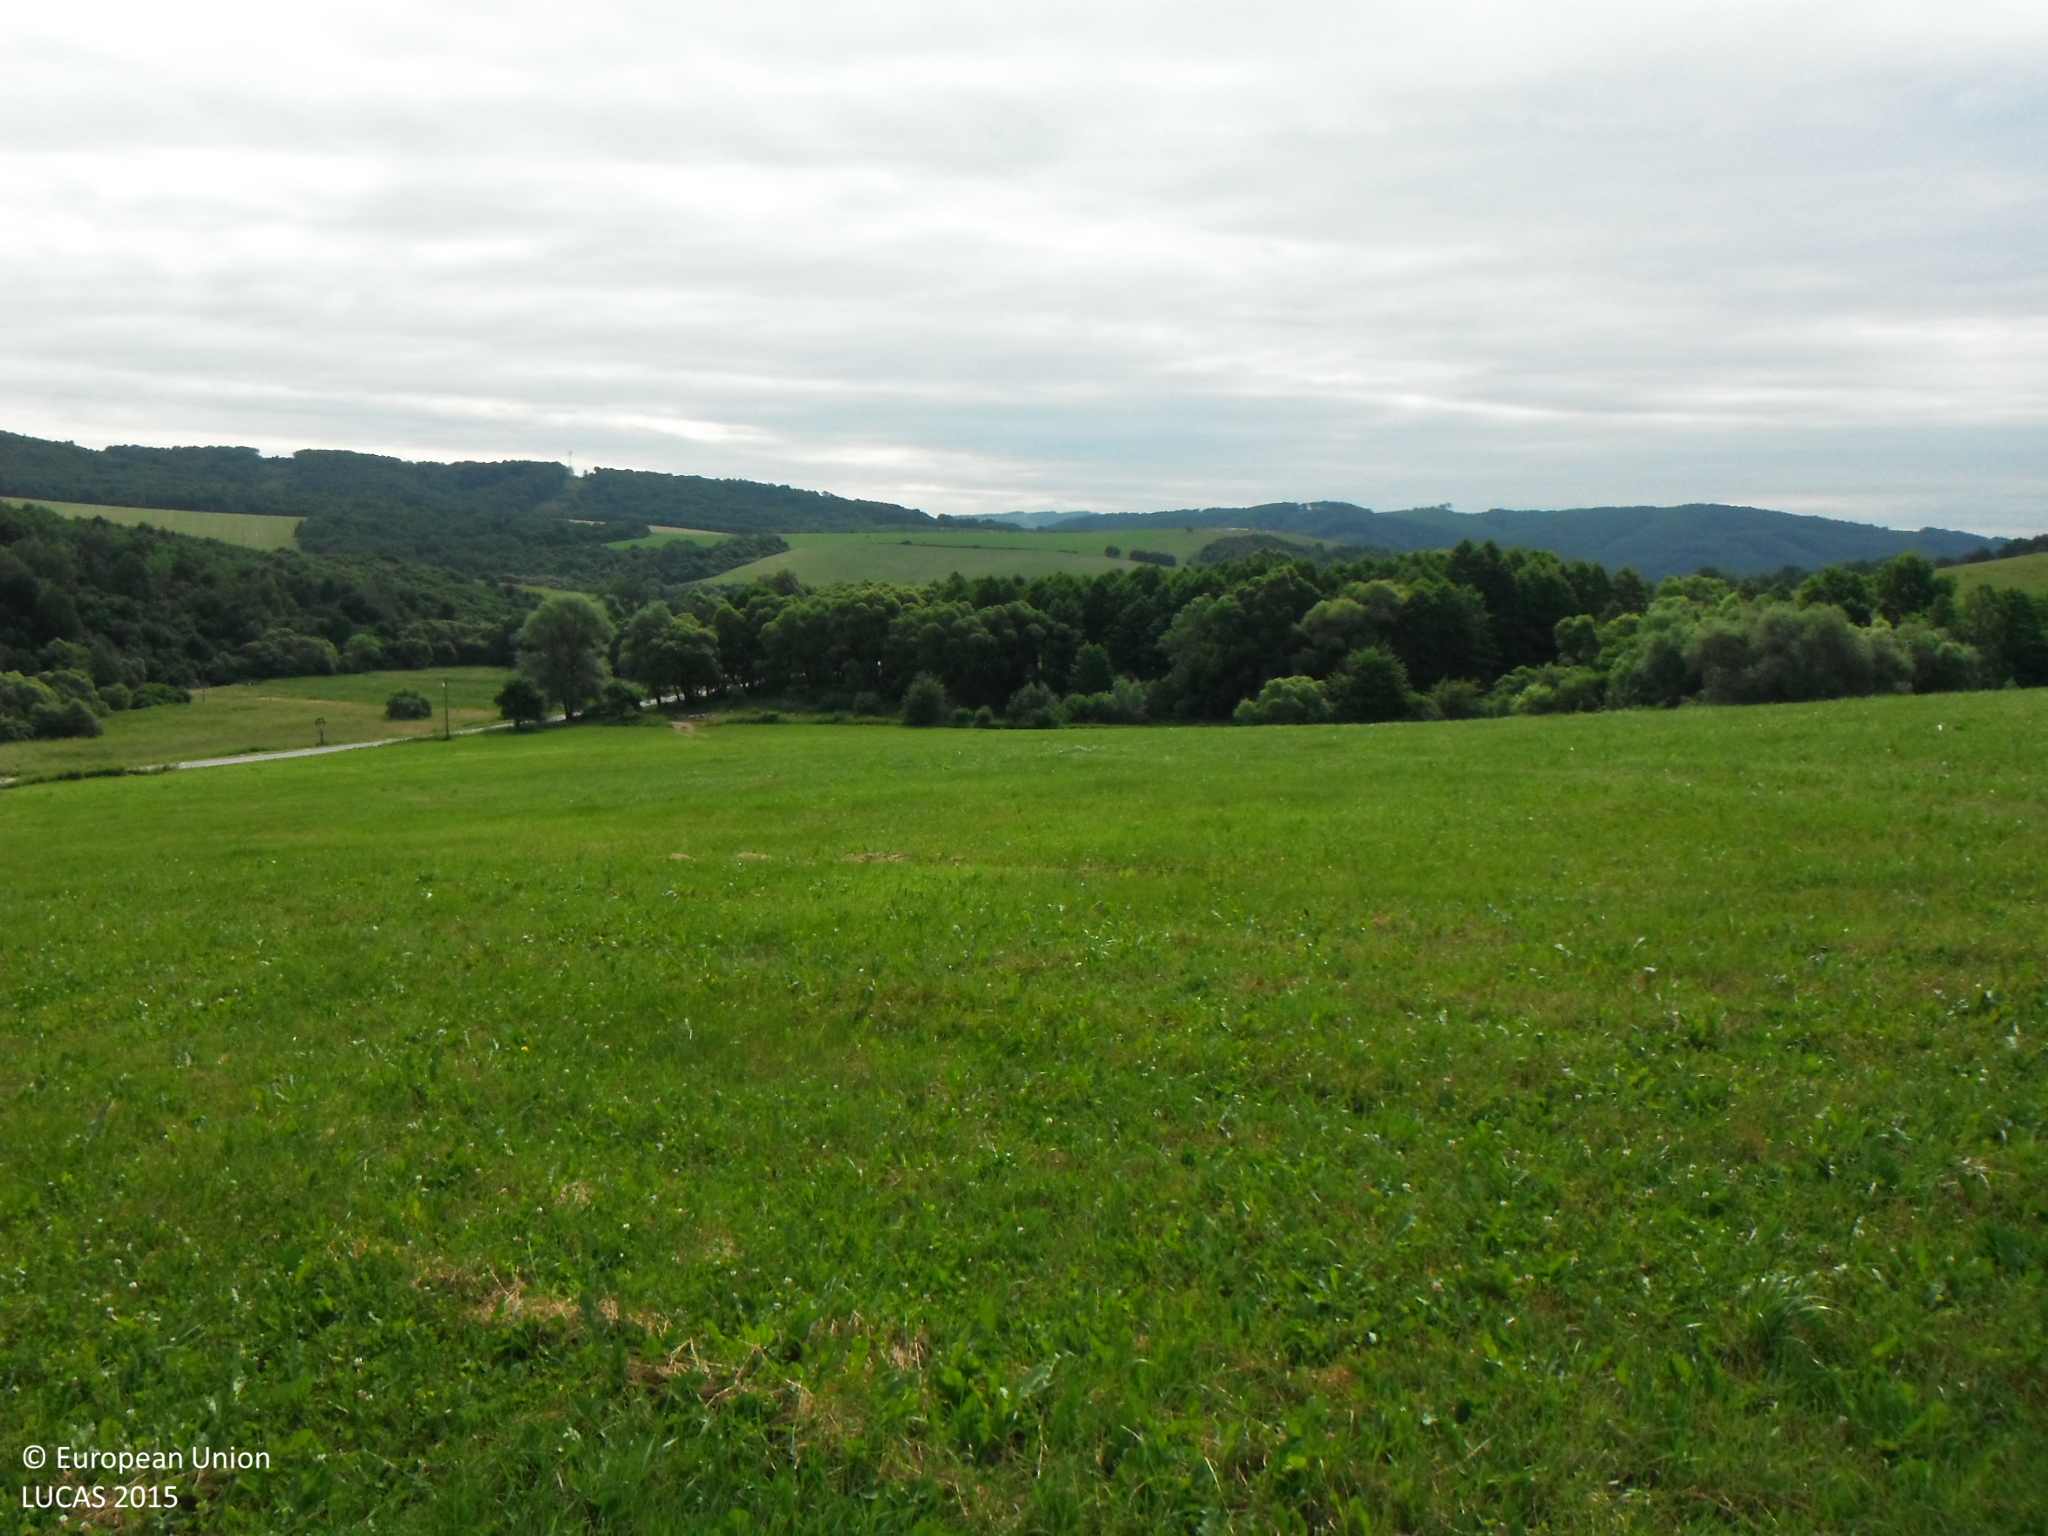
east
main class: Grassland
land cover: Grassland without tree/shrub cover
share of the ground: > 75 %
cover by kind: herbaceous plants 100 %
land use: Agriculture (excluding fallow land and kitchen gardens)
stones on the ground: < 10 %
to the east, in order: Grassland without tree/shrub cover; Tracks; Grassland without tree/shrub cover; Fences; Spontaneously vegetated surfaces; Tracks; Shrubland without tree cover
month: June
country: SK
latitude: 49.1528
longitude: 21.6086
